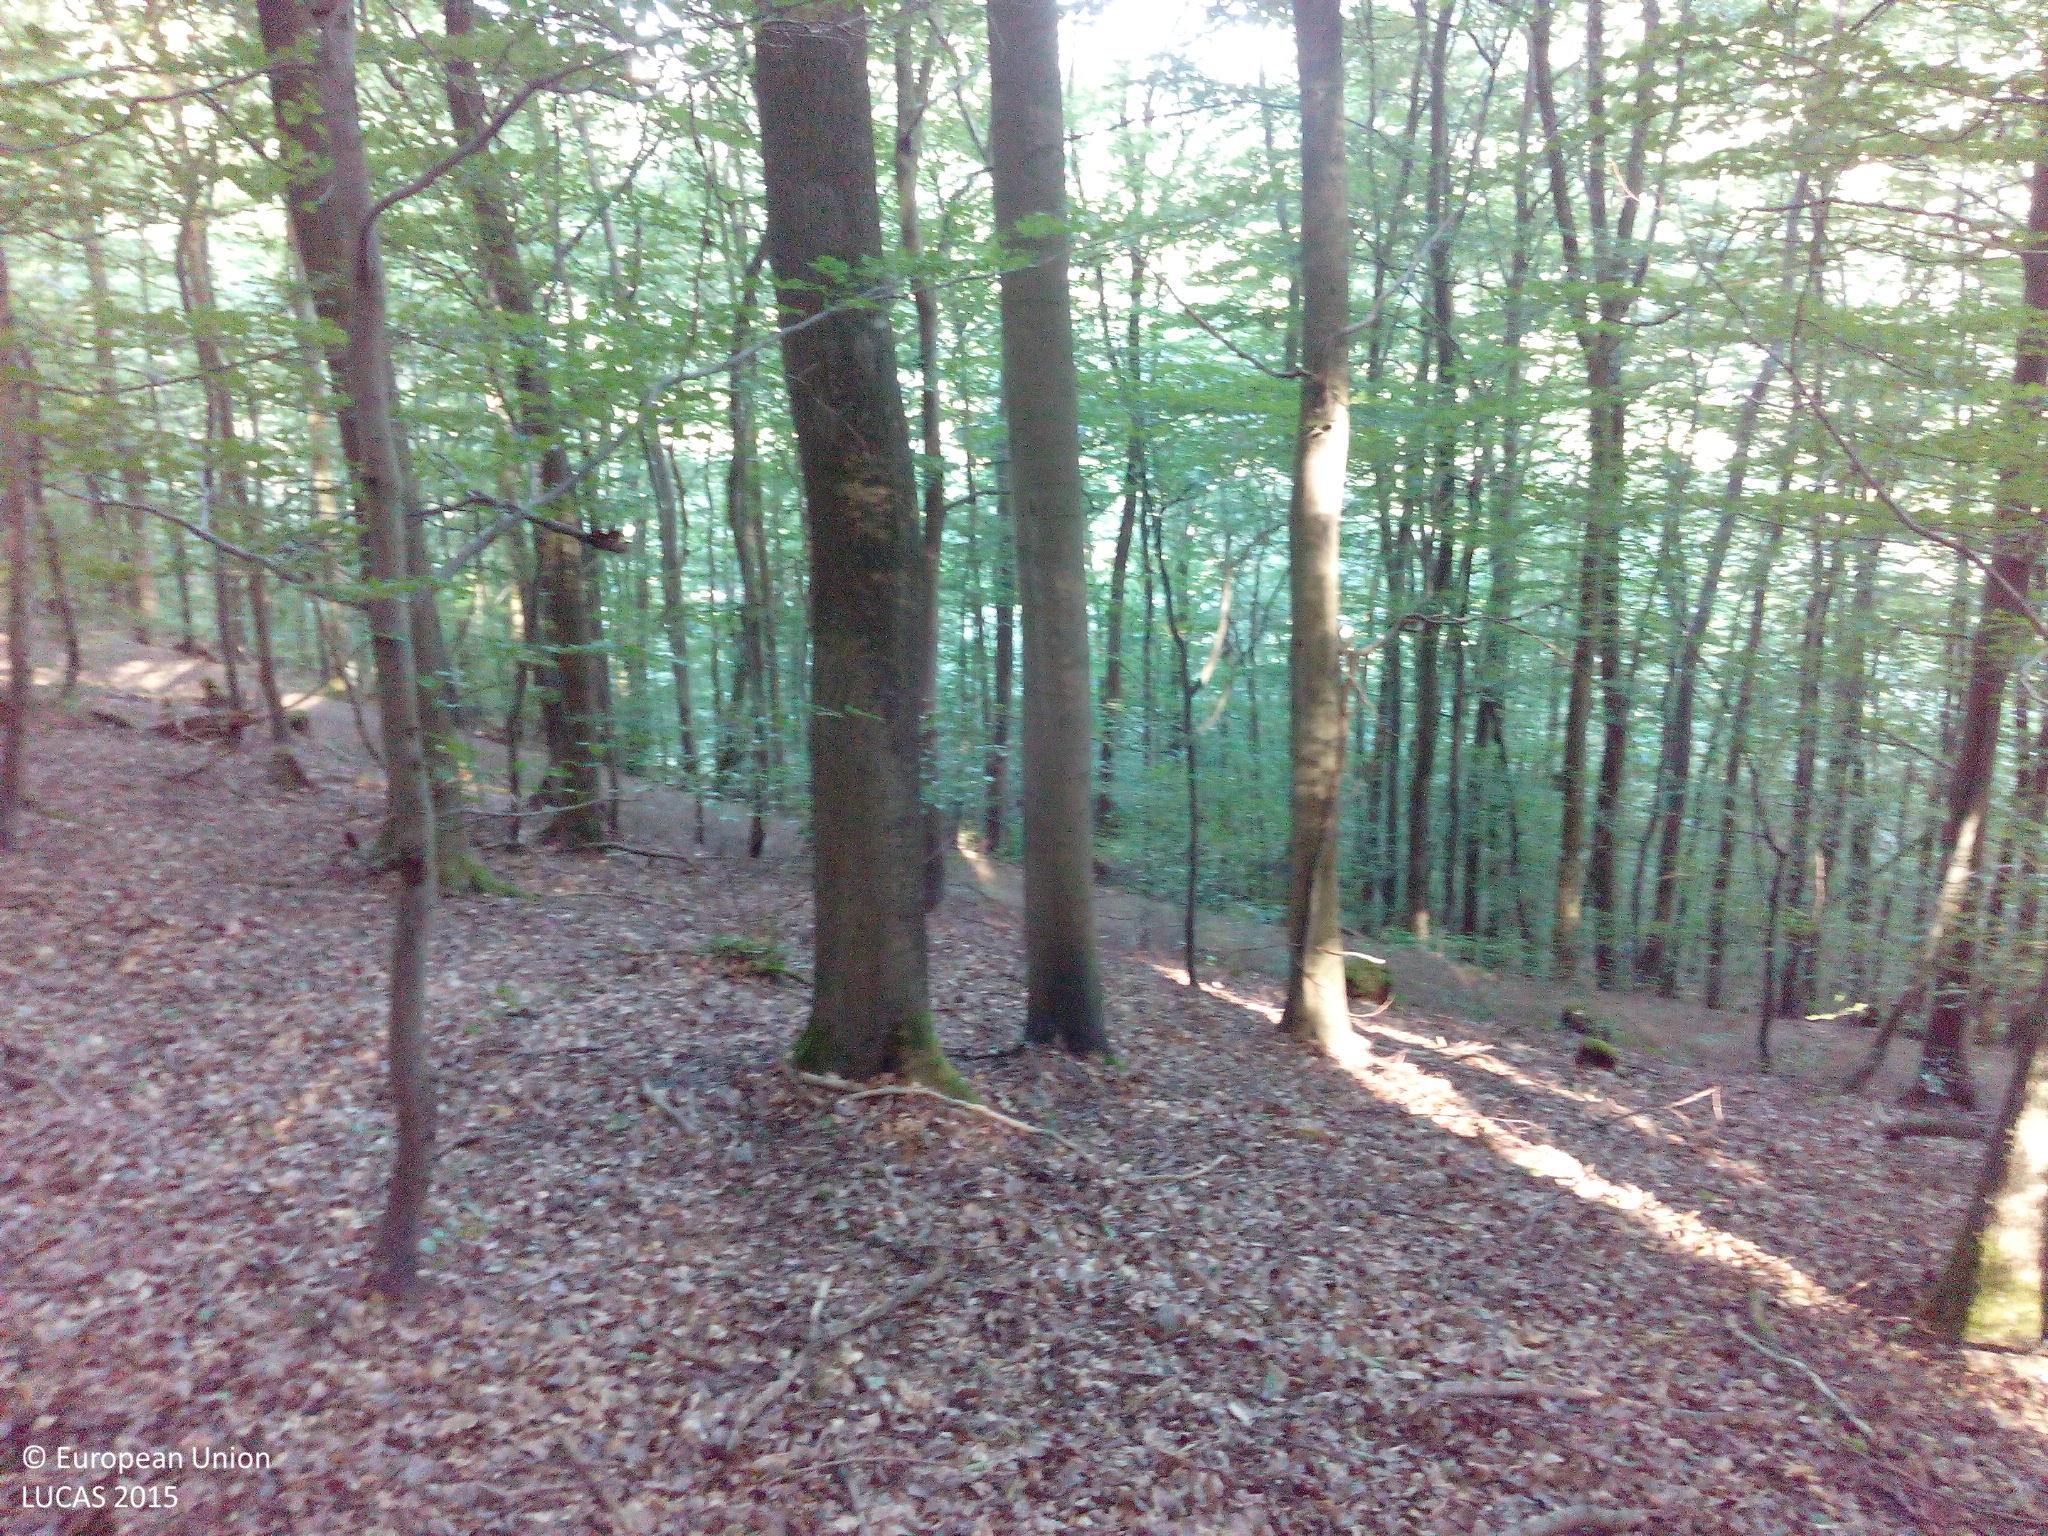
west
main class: Woodland
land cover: Broadleaved woodland
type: beech forest
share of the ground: > 75 %
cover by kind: broadleaved forest trees 90 %, unconsolidated bare surface 10 %
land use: Forestry
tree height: > 5 m
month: July
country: DE
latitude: 49.8153
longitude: 7.5127
